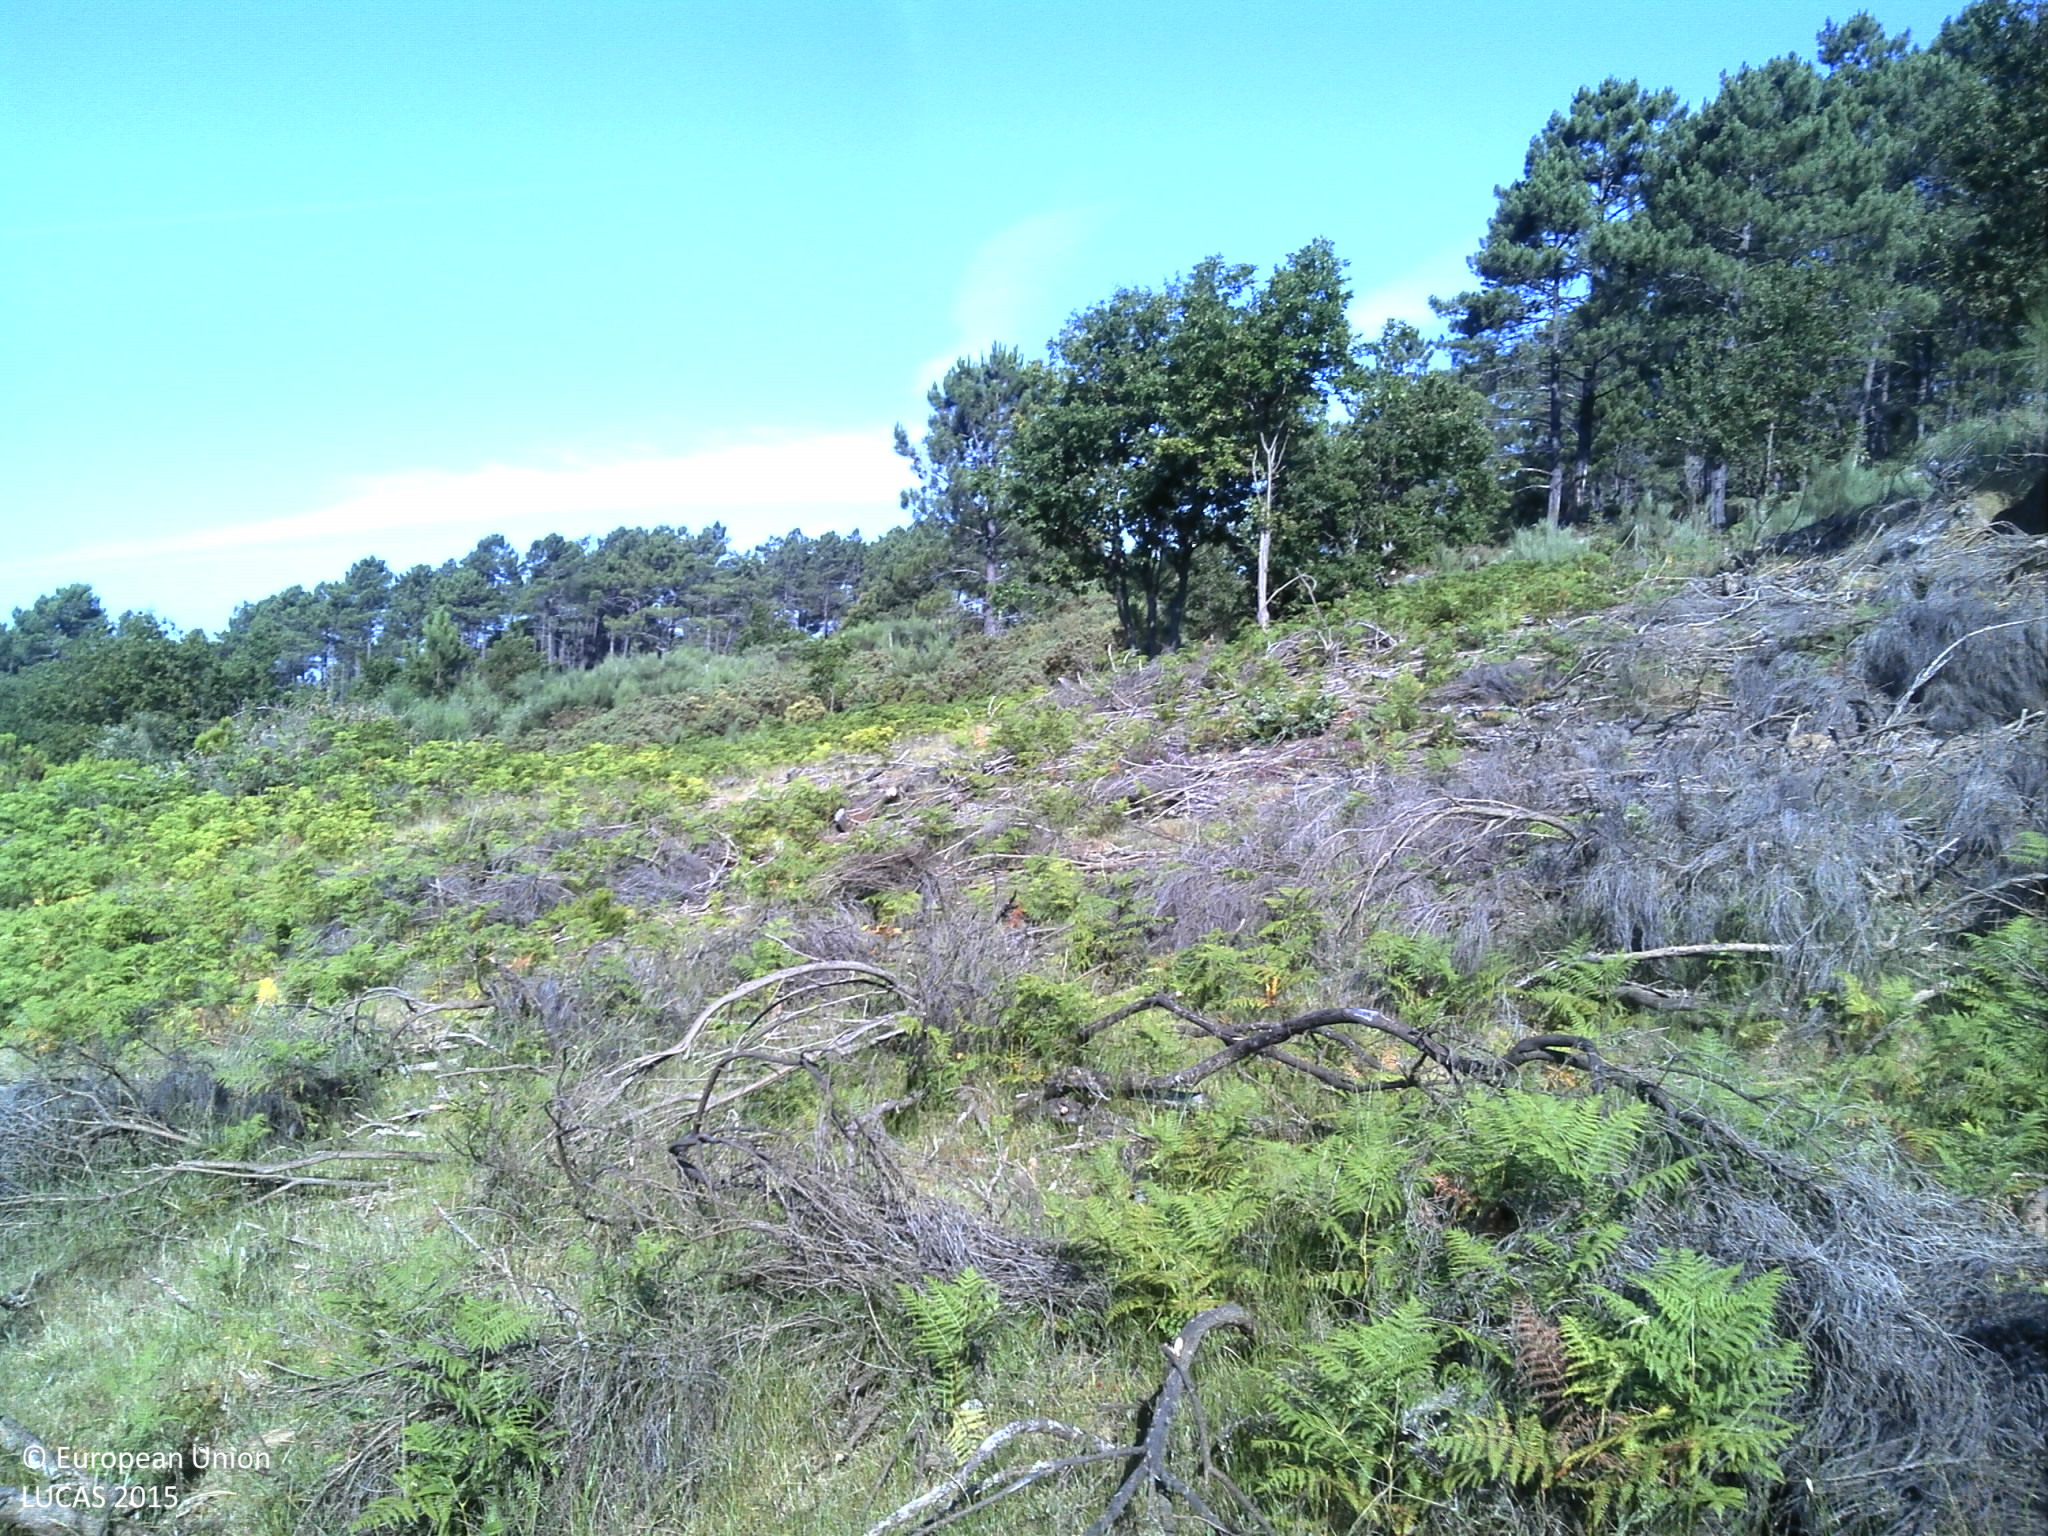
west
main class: Shrubland
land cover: Shrubland with sparse tree cover
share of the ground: > 75 %
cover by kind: shrubs 80 %, herbaceous plants 10 %, broadleaved forest trees 5 %, unconsolidated bare surface 5 %
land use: Agriculture (excluding fallow land and kitchen gardens)
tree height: < 5 m
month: July
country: PT
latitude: 41.4254
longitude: -7.8323
